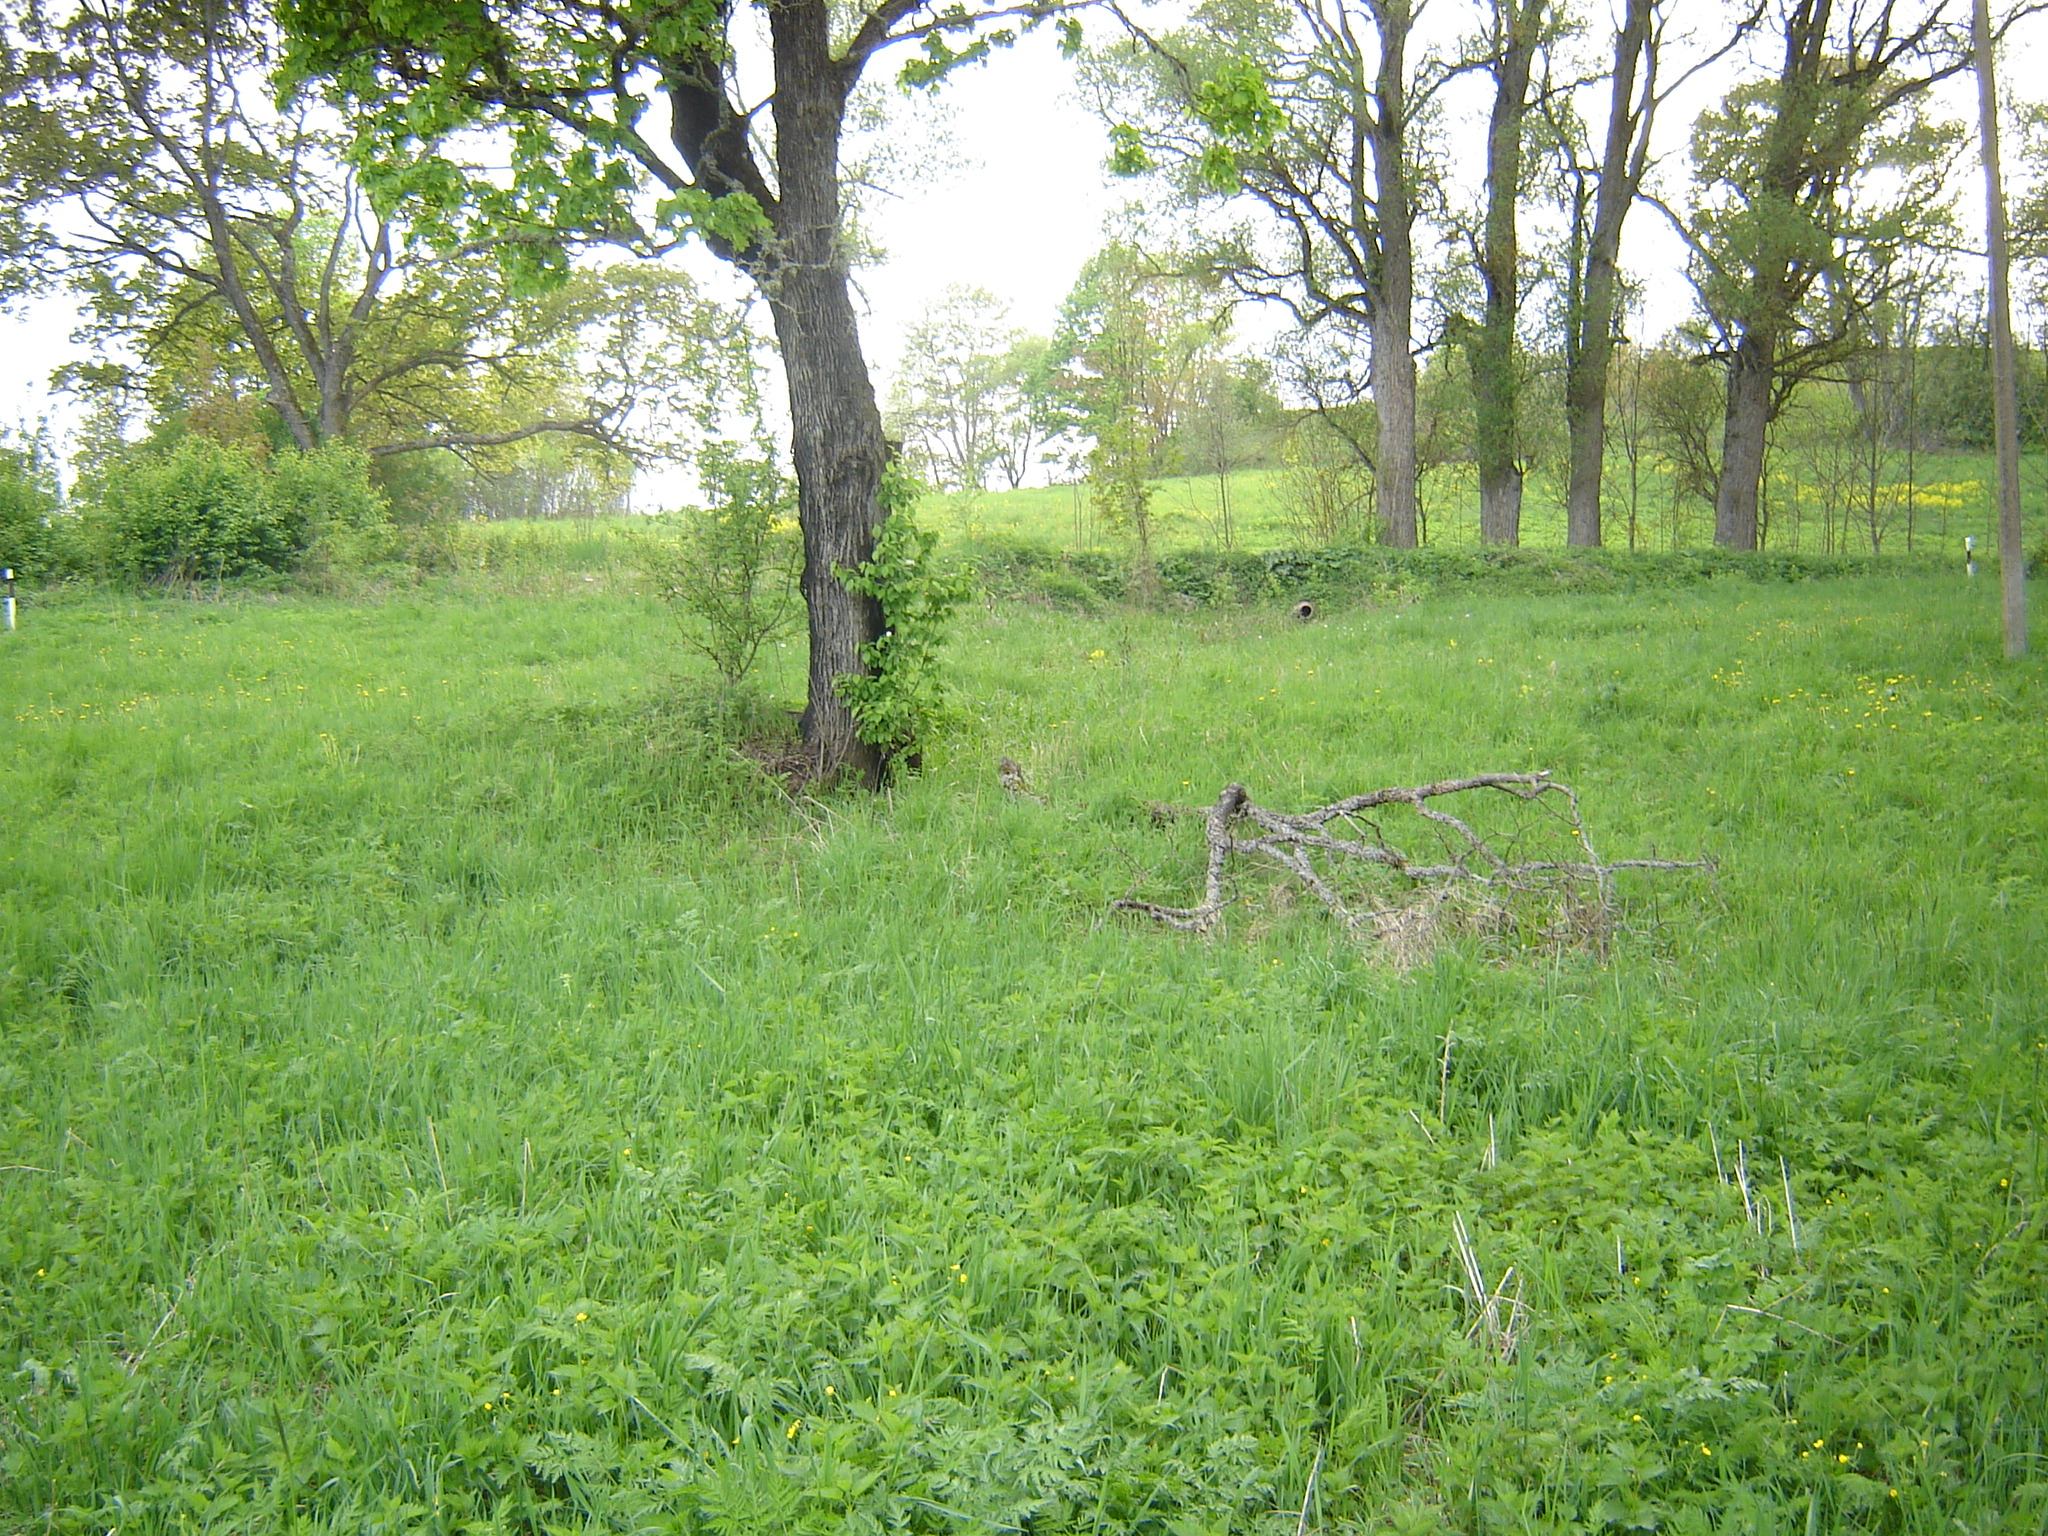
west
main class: Grassland
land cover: Grassland without tree/shrub cover
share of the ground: > 75 %
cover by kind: herbaceous plants 100 %
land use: Agriculture (excluding fallow land and kitchen gardens)
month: May
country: LT
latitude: 55.9204
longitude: 25.7635
